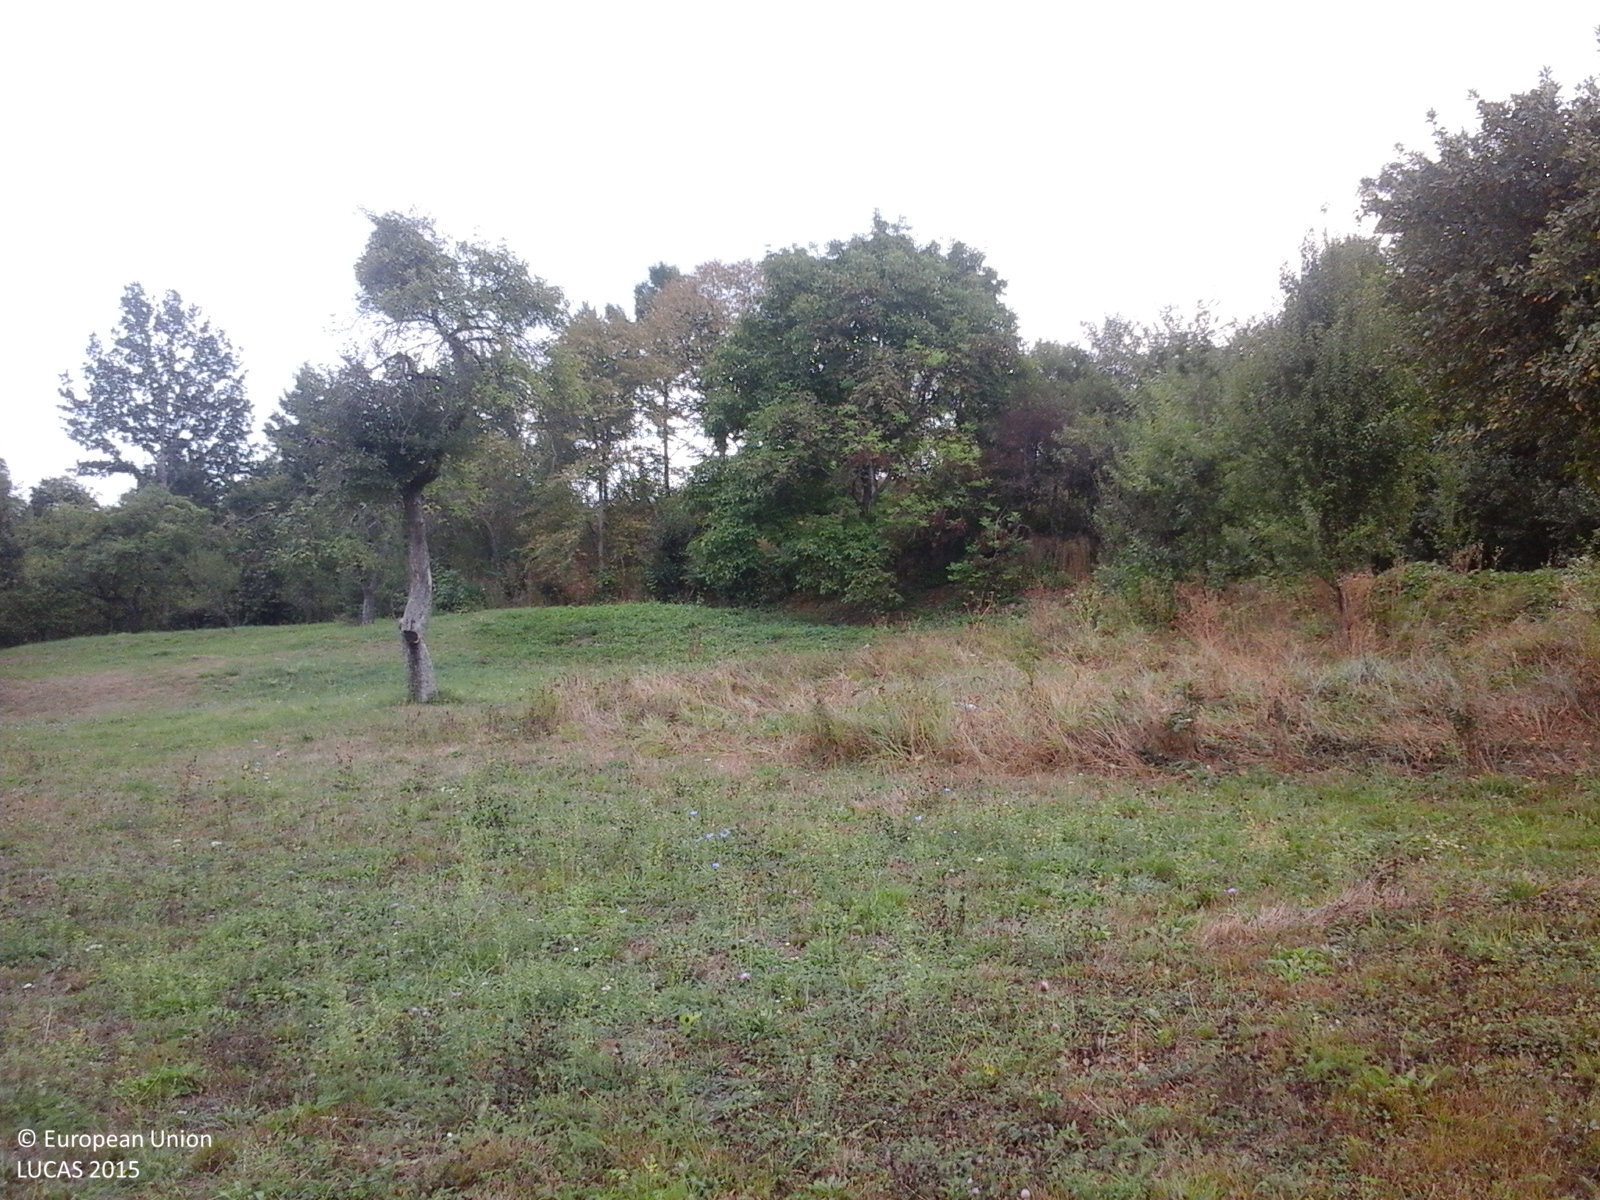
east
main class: Grassland
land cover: Grassland without tree/shrub cover
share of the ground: > 75 %
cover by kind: herbaceous plants 100 %
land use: Agriculture (excluding fallow land and kitchen gardens)
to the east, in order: Grassland without tree/shrub cover; Shrubland with sparse tree cover; Permanent crops (only in case pi); Arable land (only in case pi); Permanent crops (only in case pi)
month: September
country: RO
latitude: 47.5593
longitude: 23.5919
